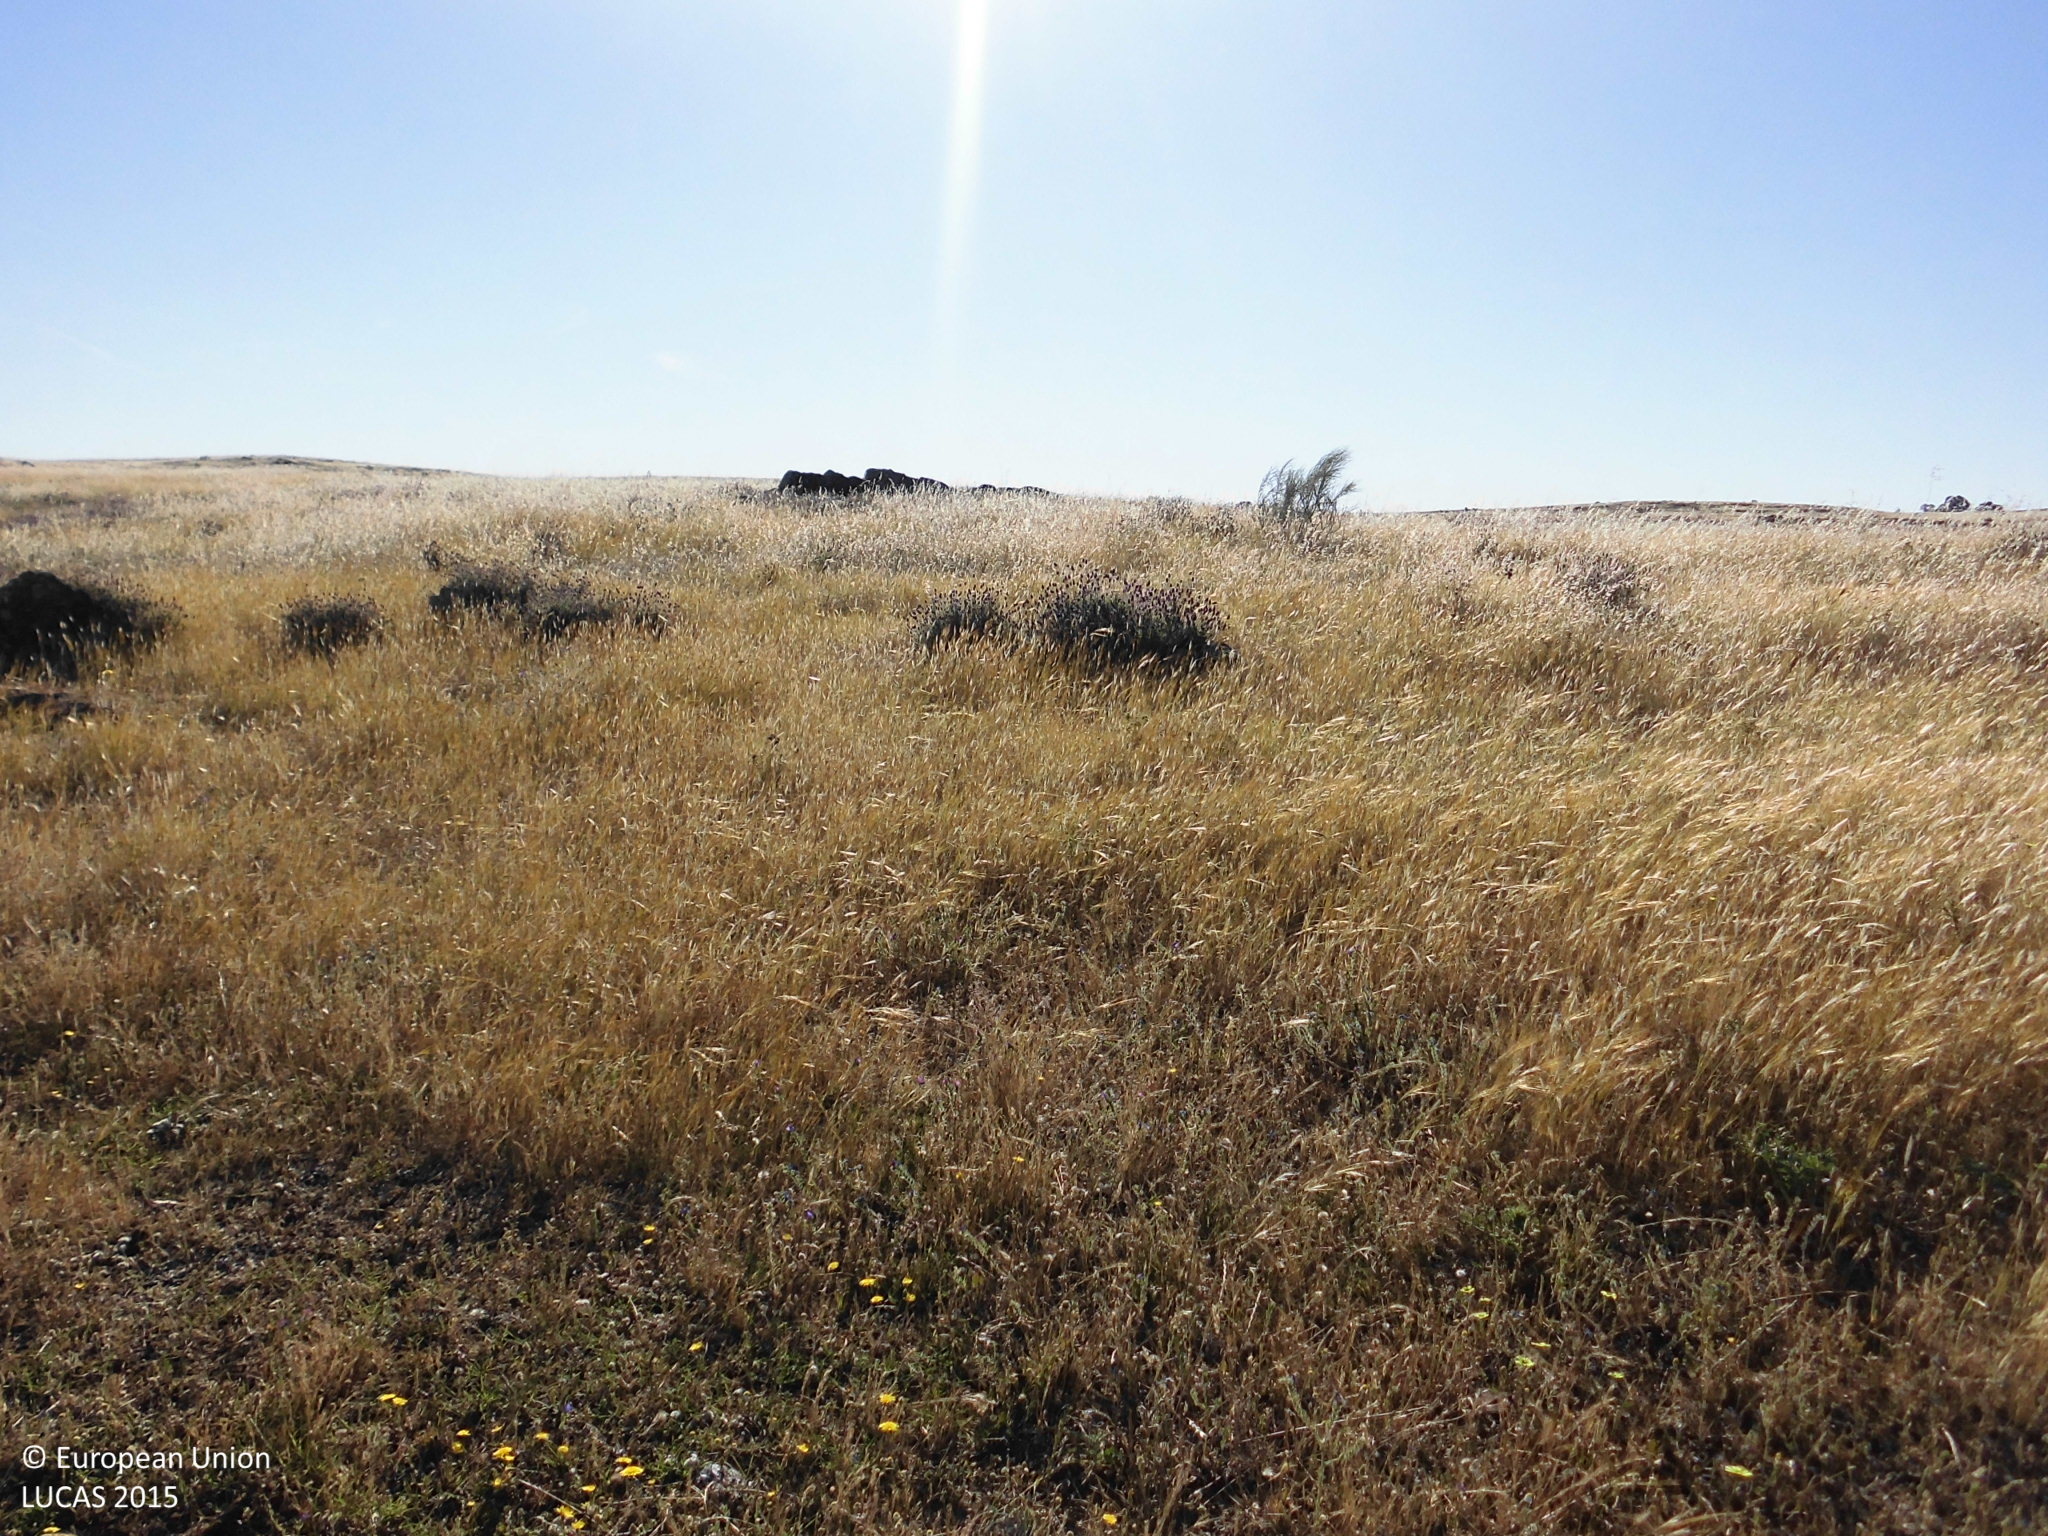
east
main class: Woodland
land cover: Broadleaved woodland
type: broadleaved evergreen forest
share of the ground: 10 - 25 %
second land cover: Grassland without tree/shrub cover
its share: > 75 %
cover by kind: herbaceous plants 85 %, broadleaved forest trees 15 %
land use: Forestry
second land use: Agriculture (excluding fallow land and kitchen gardens)
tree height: > 5 m
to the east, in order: Broadleaved woodland; Grassland without tree/shrub cover; Broadleaved woodland
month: May
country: ES
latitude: 39.4659
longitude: -6.8265
